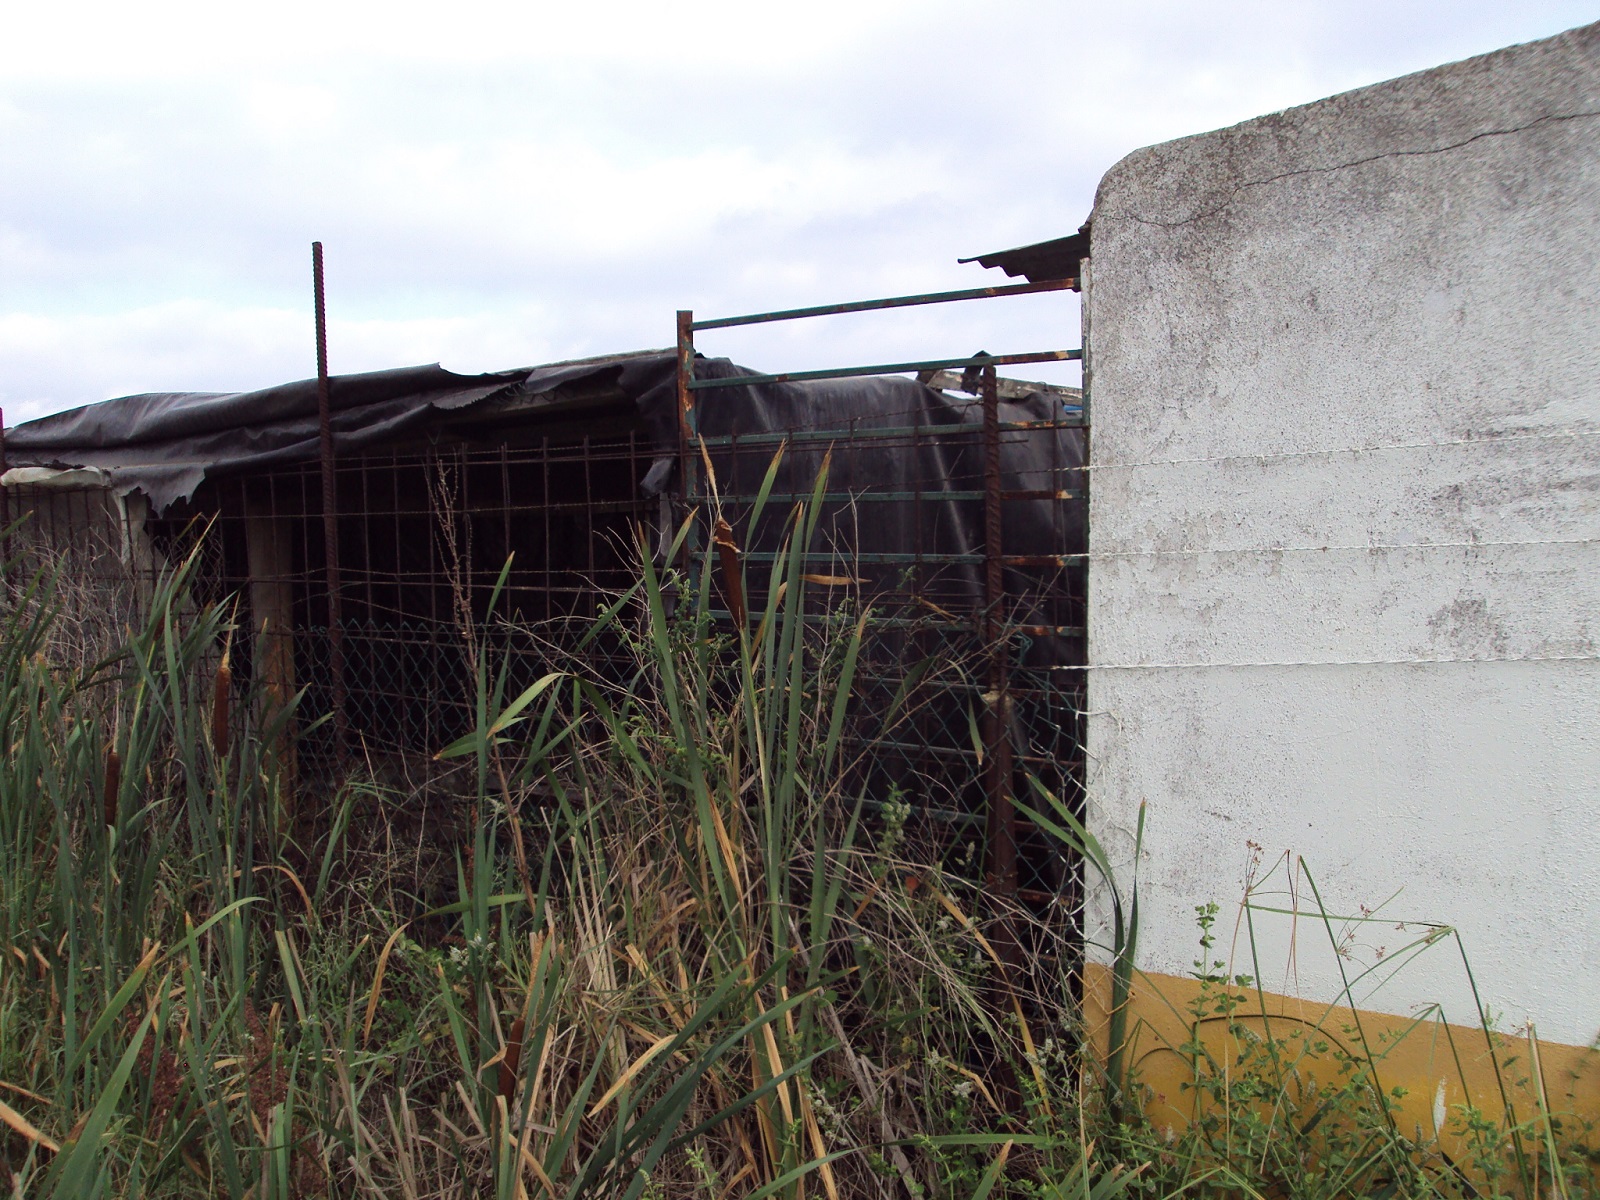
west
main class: Grassland
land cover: Spontaneously vegetated surfaces
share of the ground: > 75 %
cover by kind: herbaceous plants 100 %
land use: Semi-natural and natural areas not in use
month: June
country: ES
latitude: 37.2193
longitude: -6.9070
